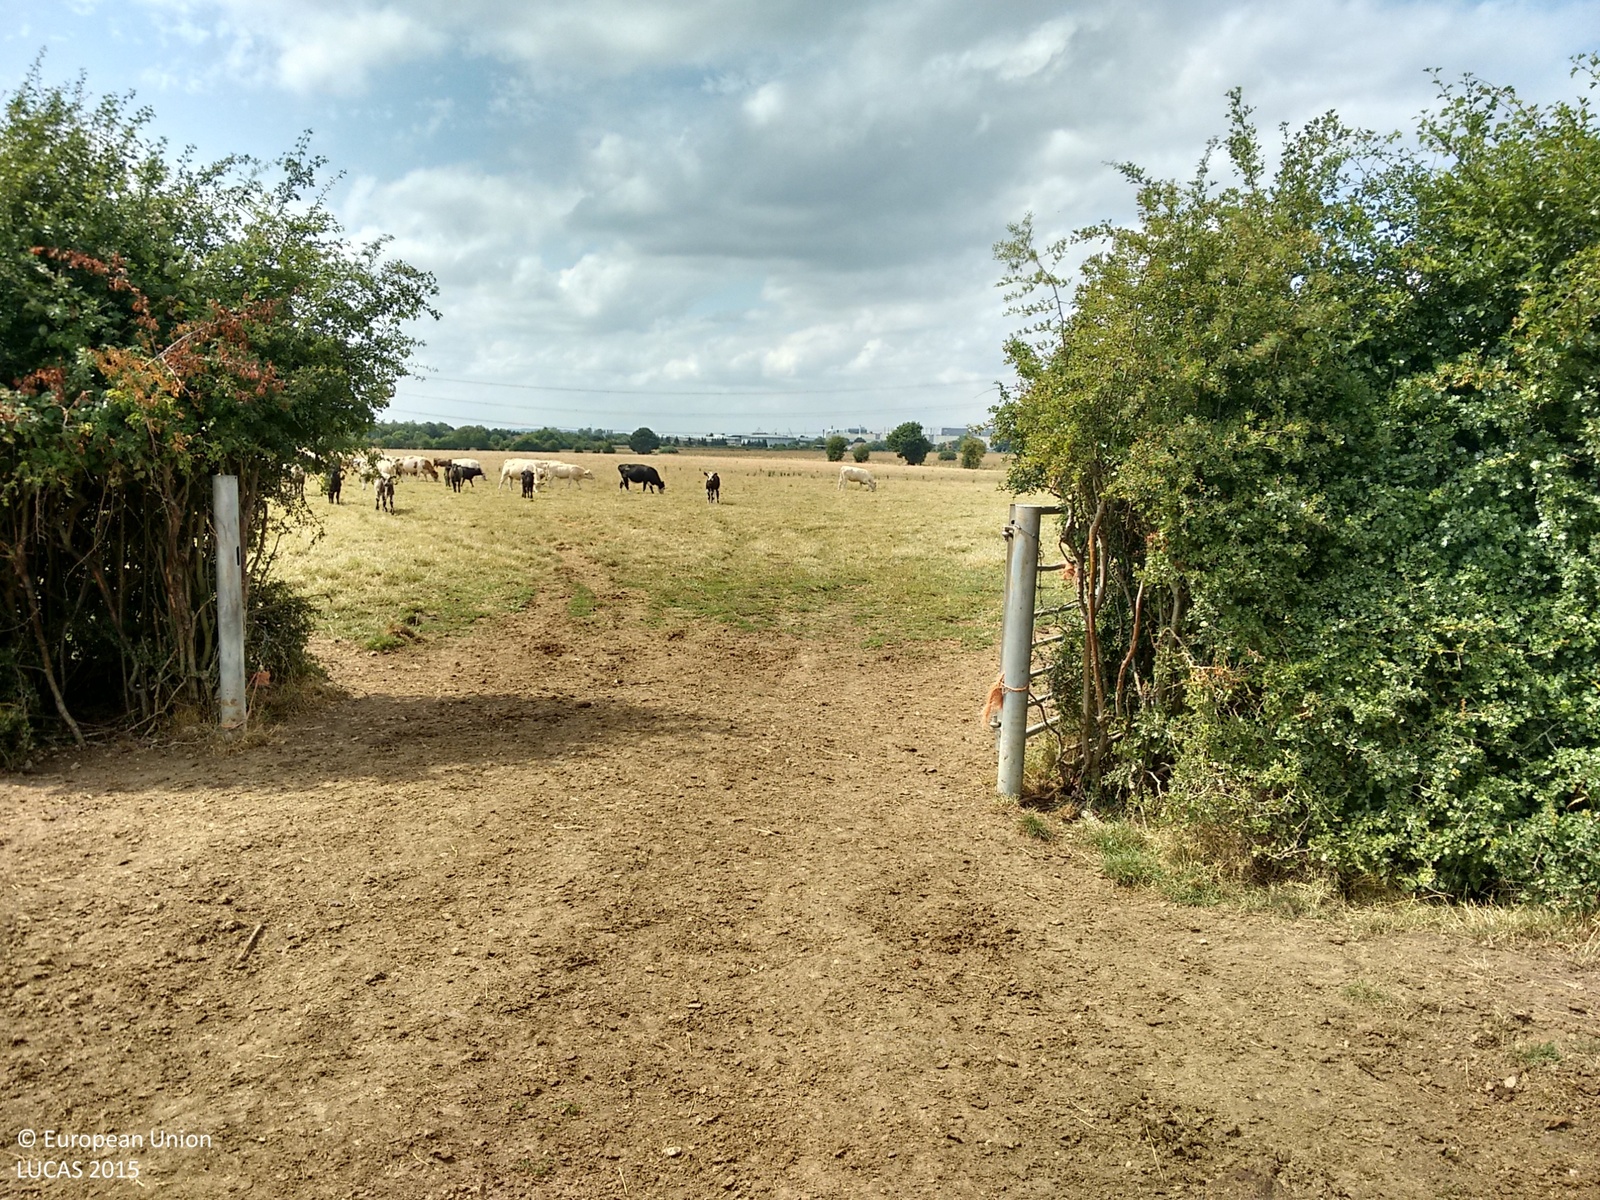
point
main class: Grassland
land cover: Grassland without tree/shrub cover
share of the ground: > 75 %
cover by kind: herbaceous plants 100 %
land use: Agriculture (excluding fallow land and kitchen gardens)
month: July
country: GB
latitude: 51.7205
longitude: -1.1786
